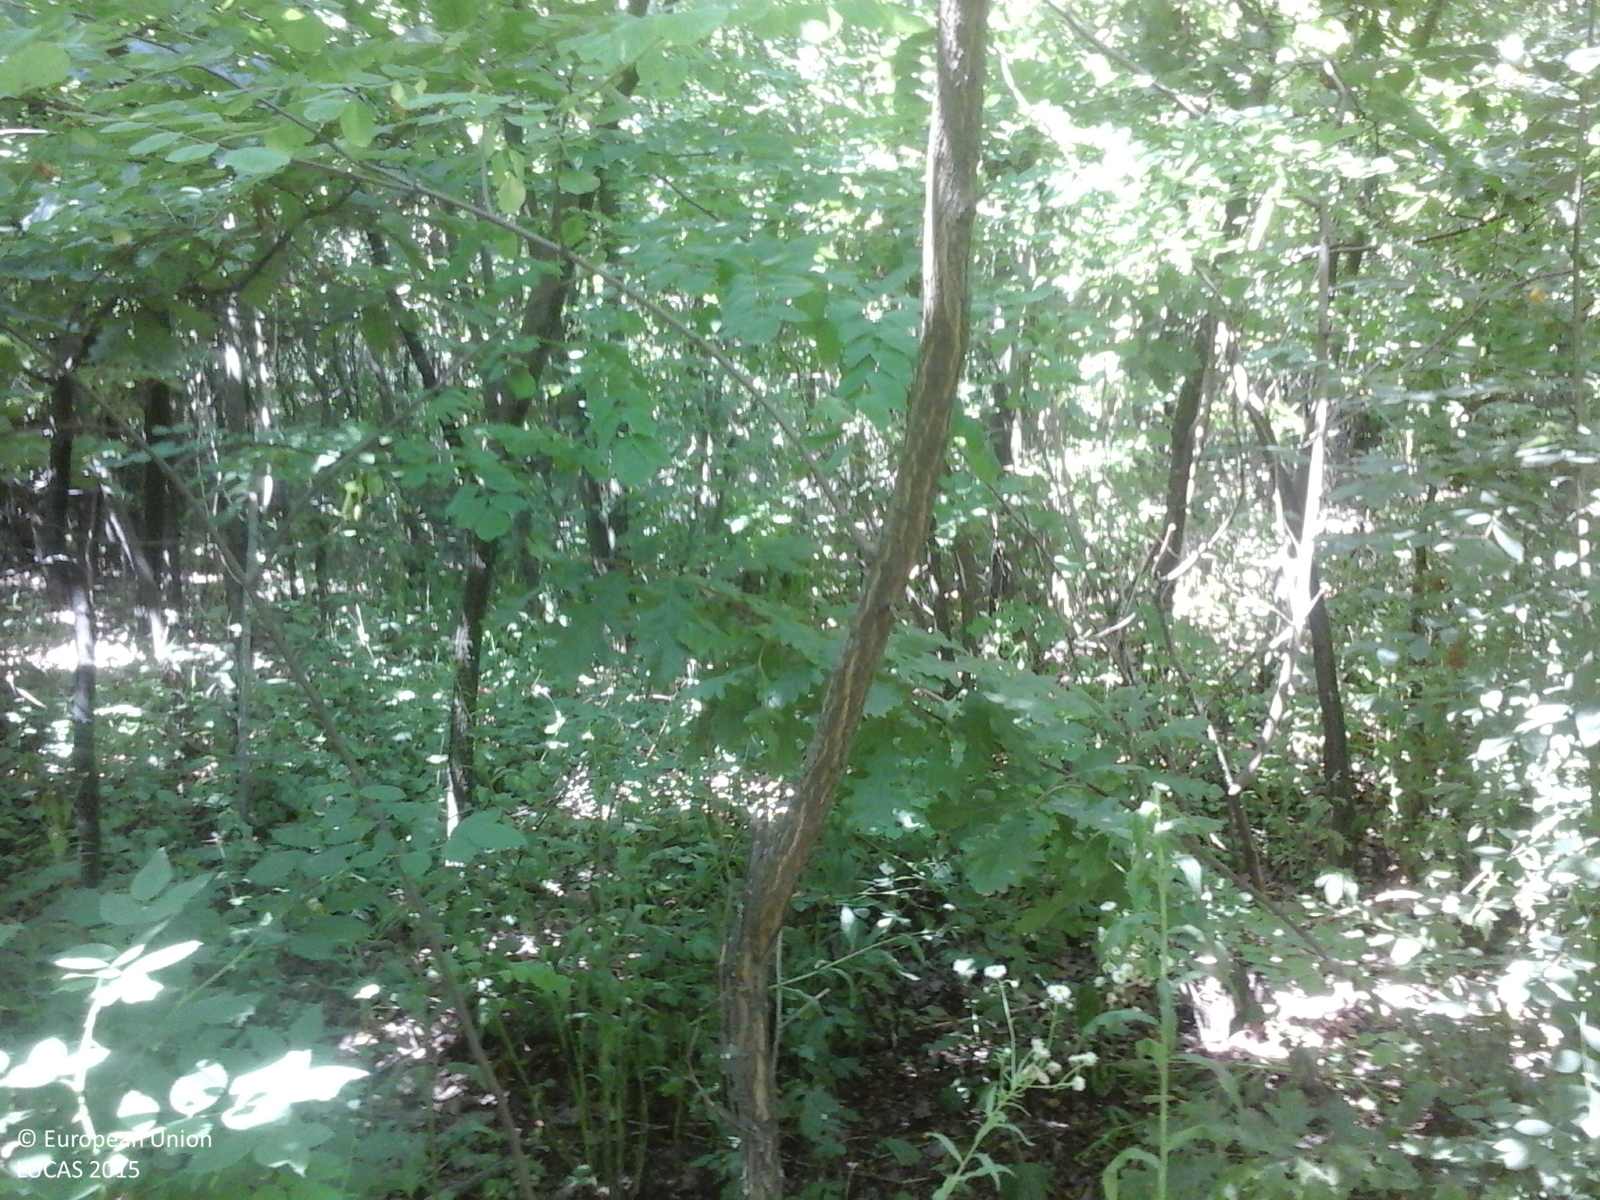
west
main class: Woodland
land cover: Broadleaved woodland
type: mesophytic deciduous forest
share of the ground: > 75 %
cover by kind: broadleaved forest trees 90 %, shrubs 5 %, herbaceous plants 5 %
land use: Forestry
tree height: > 5 m
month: July
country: RO
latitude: 44.2683
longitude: 24.5645
